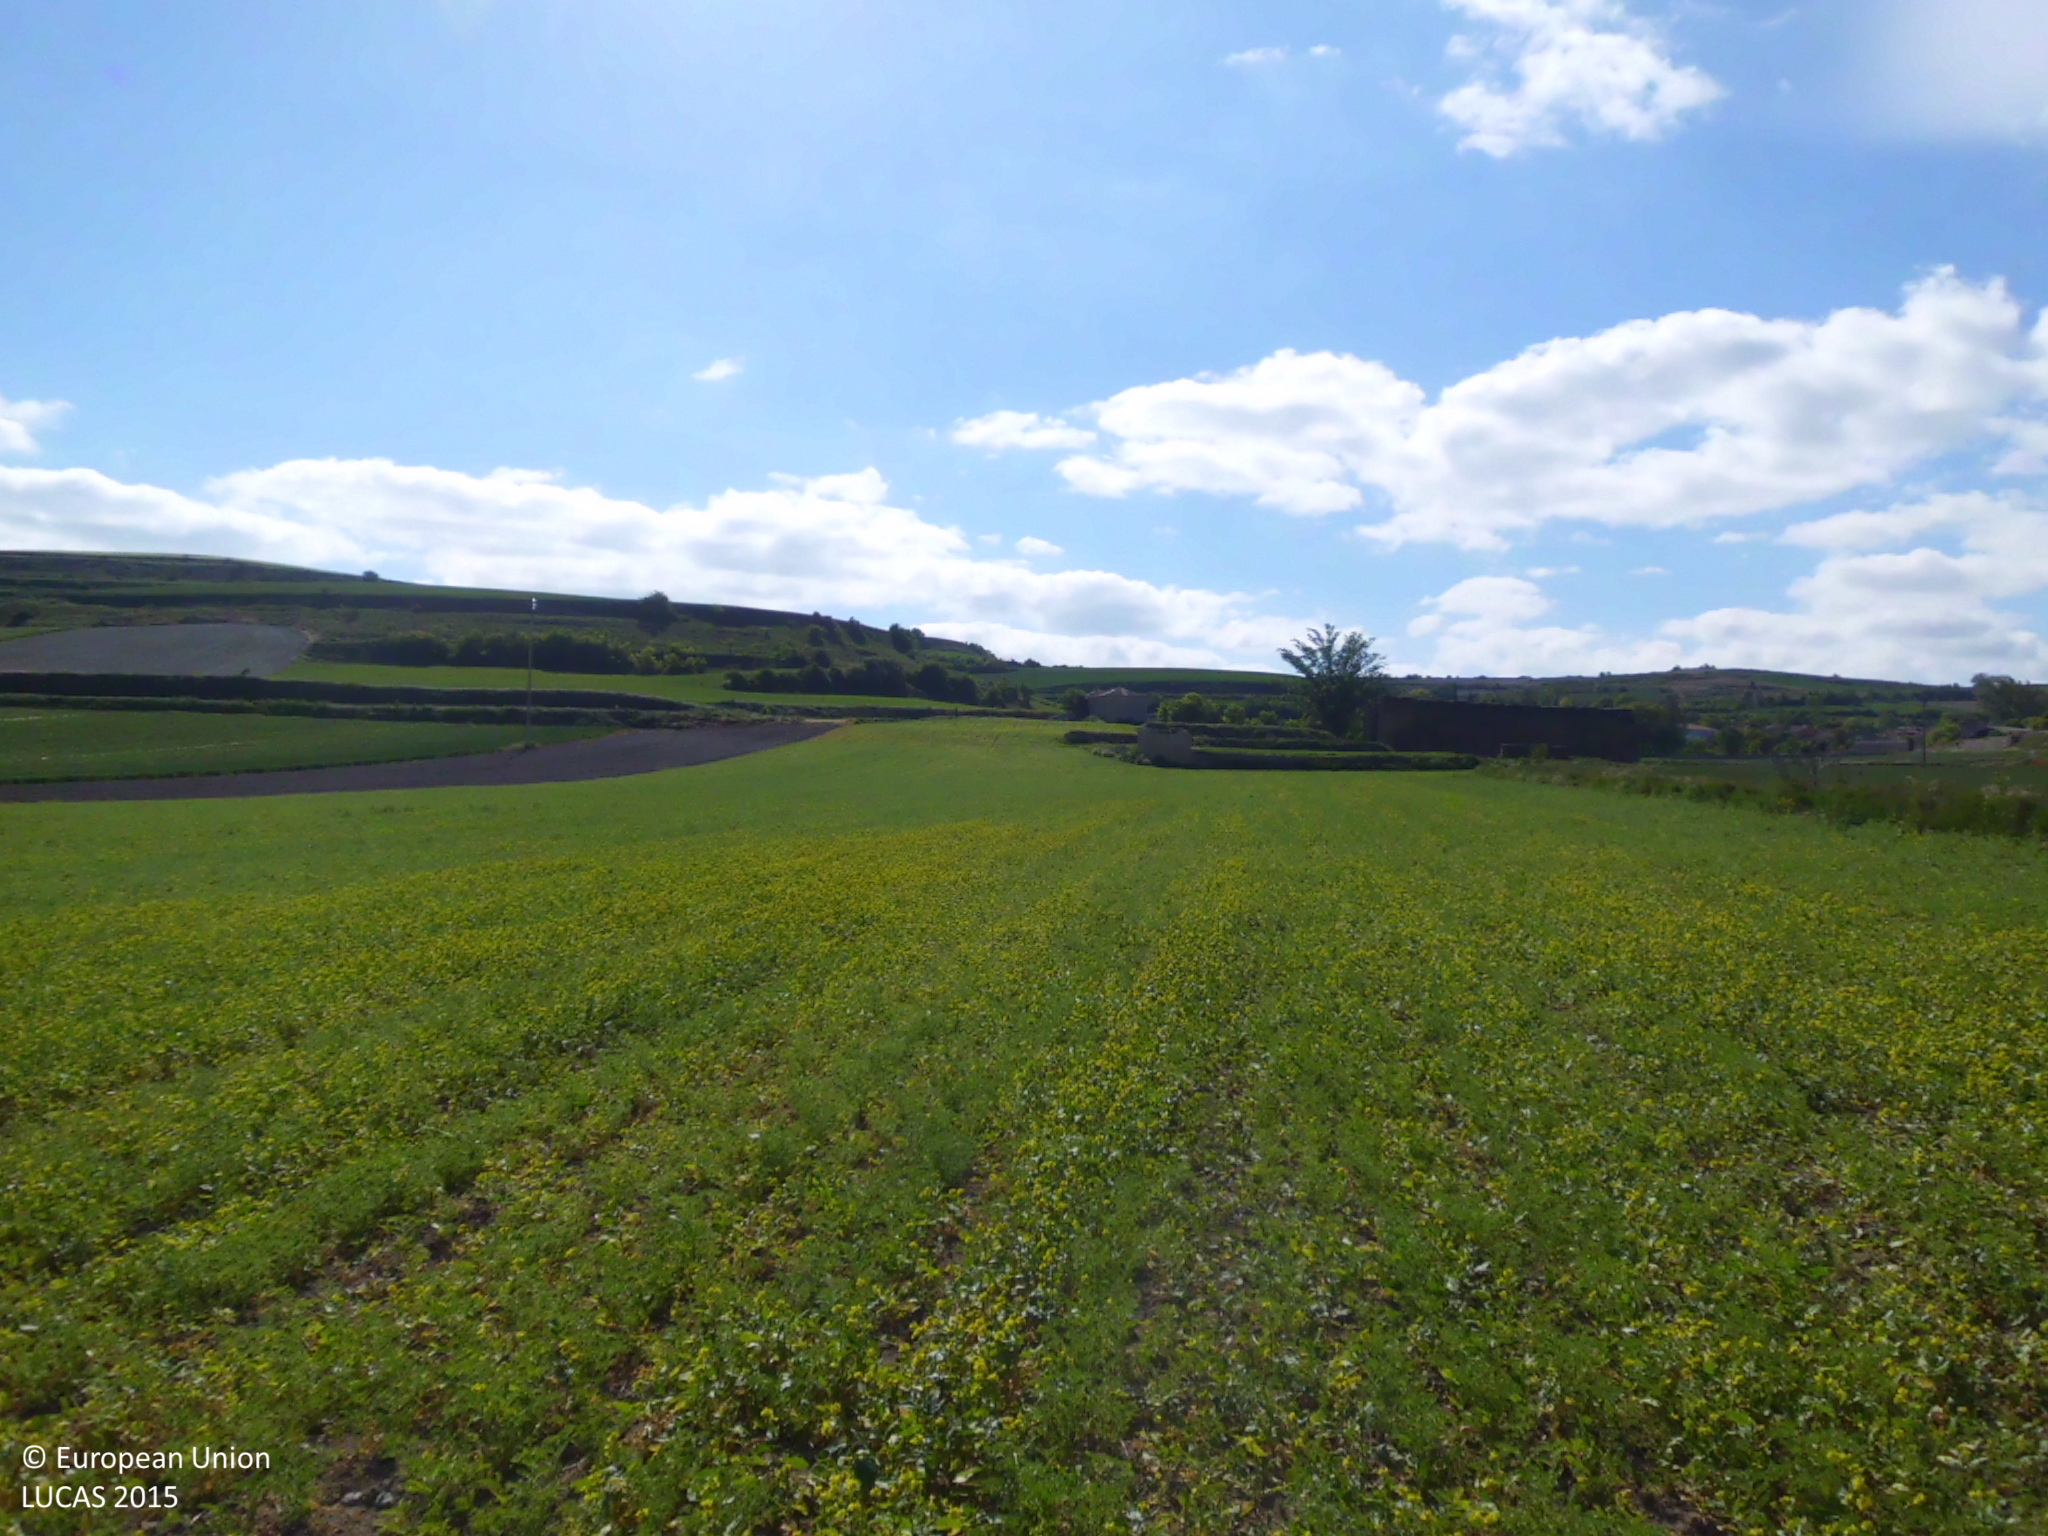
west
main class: Cropland
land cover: Lucerne
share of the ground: > 75 %
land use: Agriculture (excluding fallow land and kitchen gardens)
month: May
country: ES
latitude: 42.4533
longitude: -3.9394
